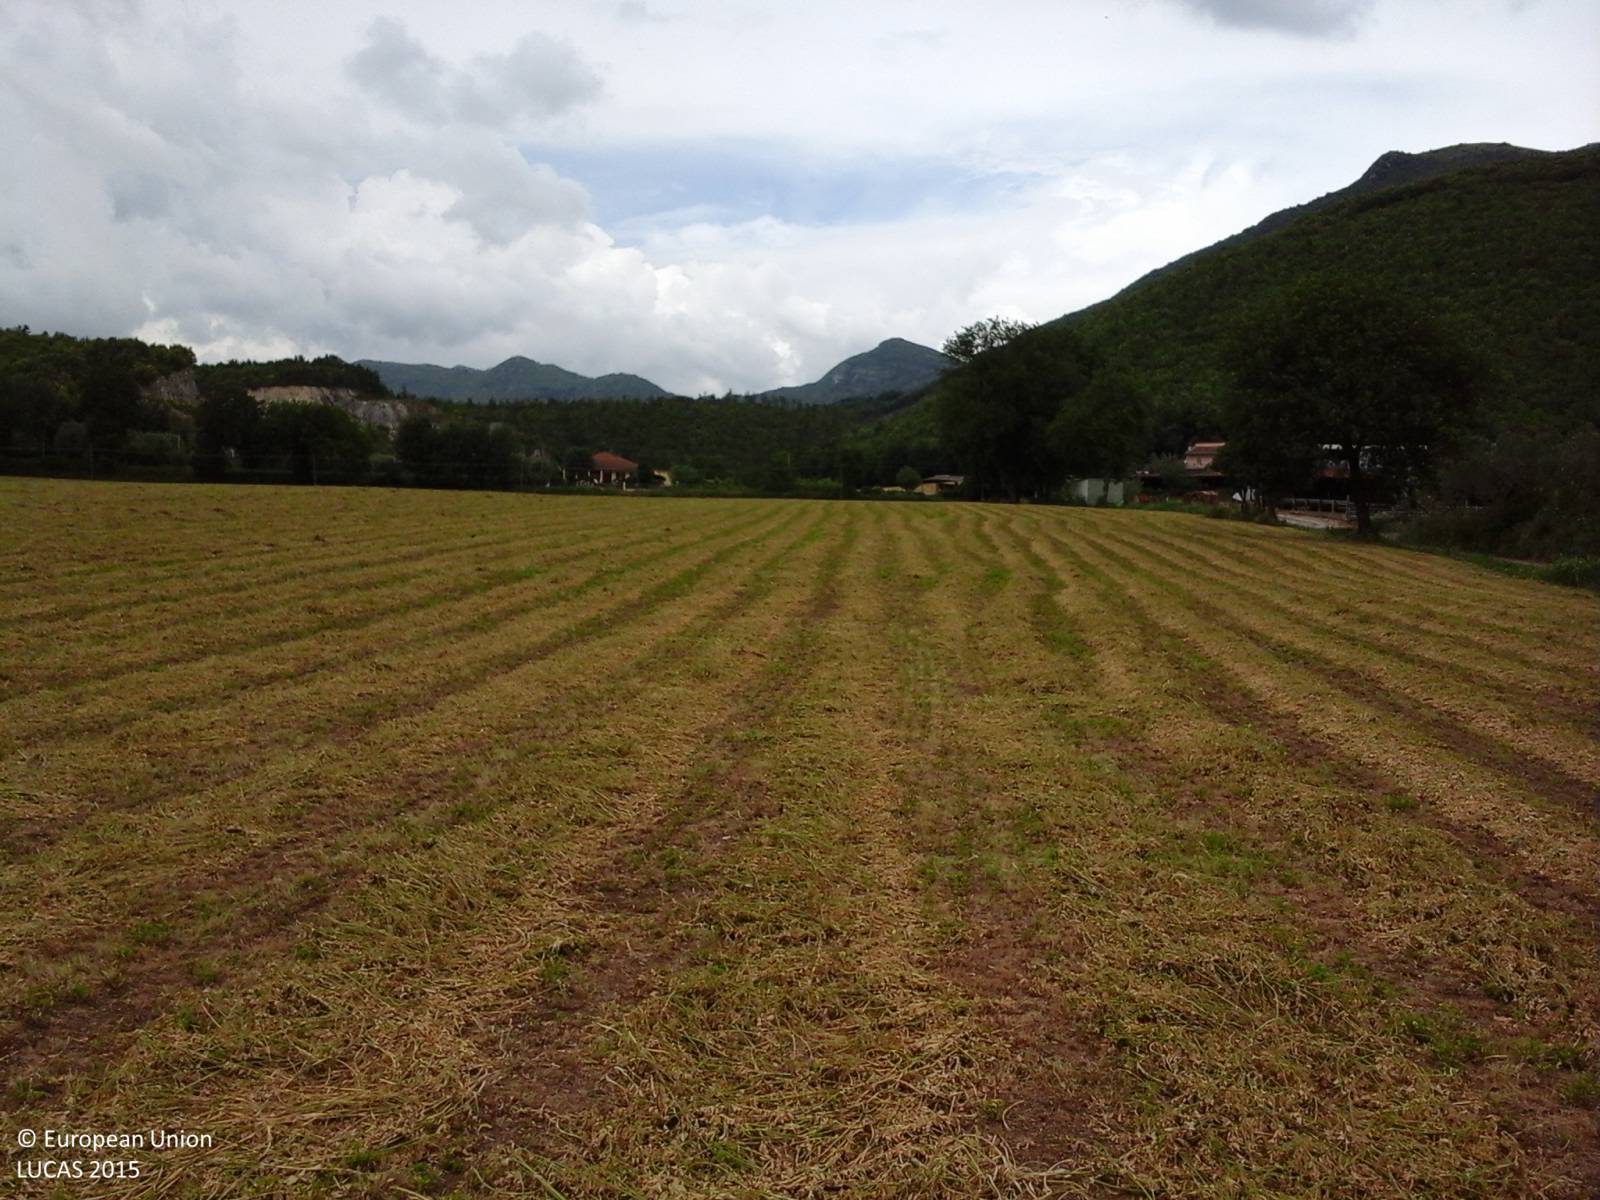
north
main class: Cropland
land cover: Lucerne
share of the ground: > 75 %
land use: Agriculture (excluding fallow land and kitchen gardens)
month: May
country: IT
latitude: 41.1891
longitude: 14.2636
